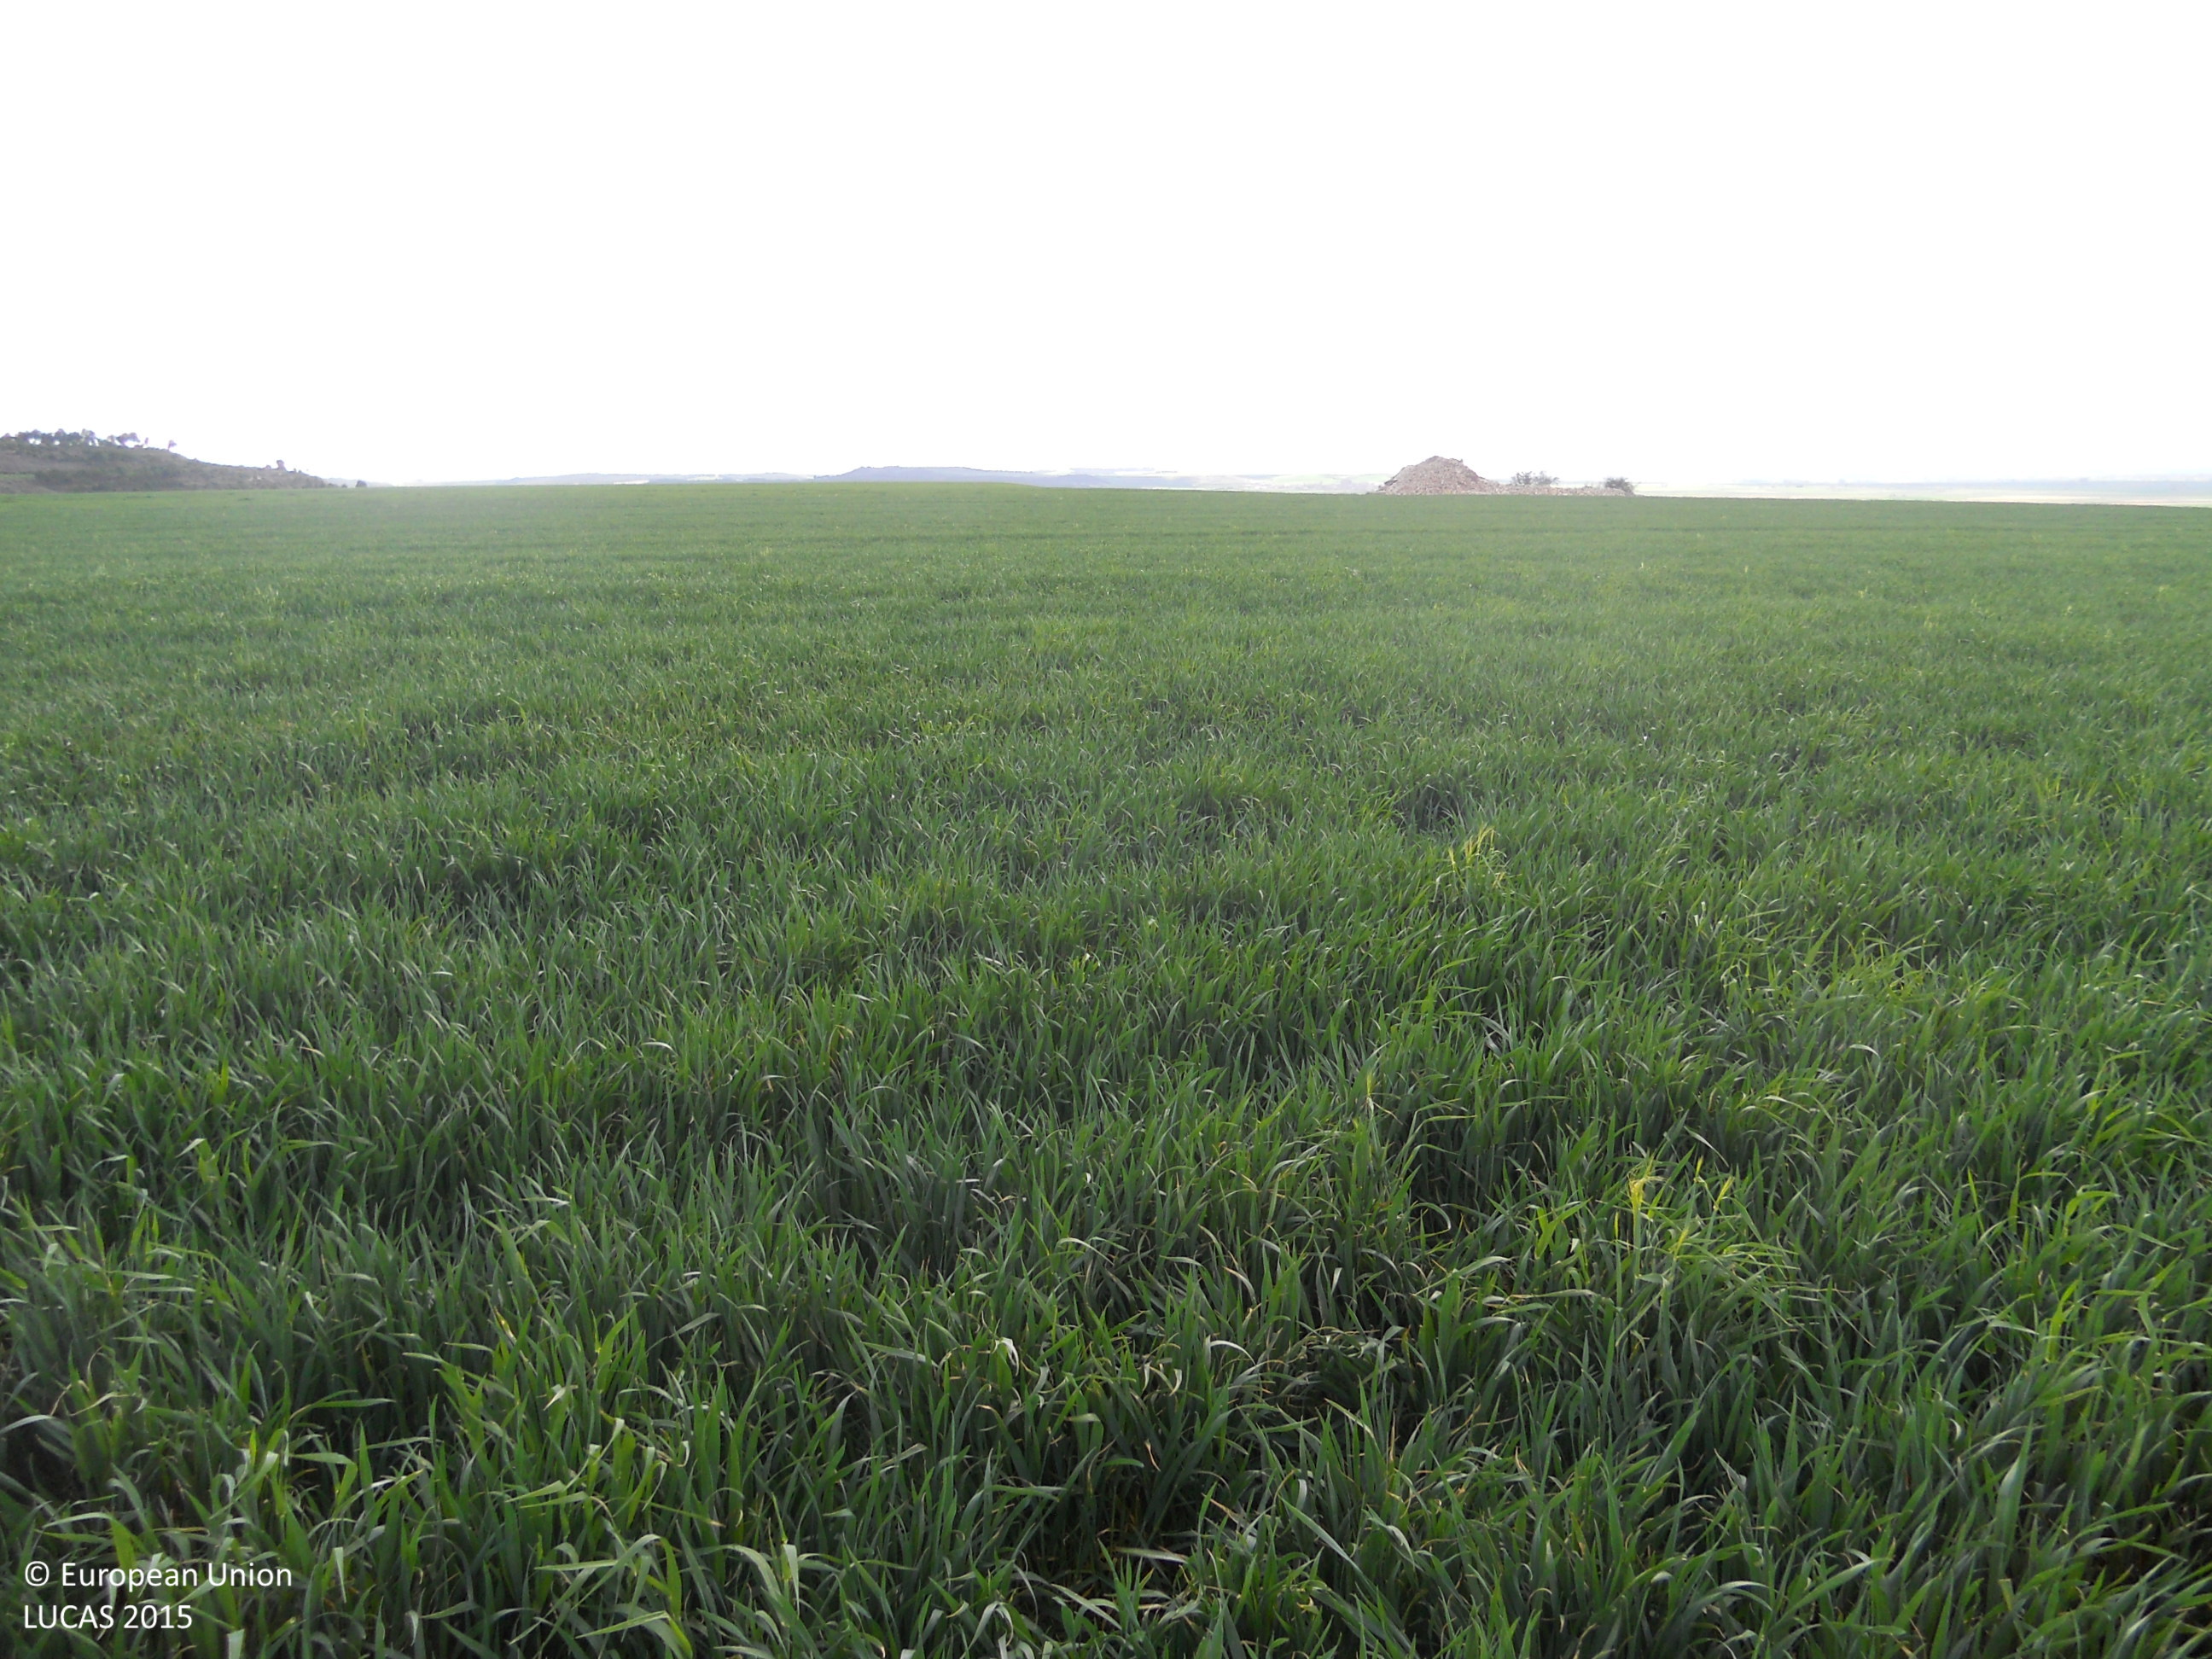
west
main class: Cropland
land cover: Barley
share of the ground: > 75 %
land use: Agriculture (excluding fallow land and kitchen gardens)
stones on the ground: < 10 %
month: April
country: ES
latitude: 42.2400
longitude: -4.2836
